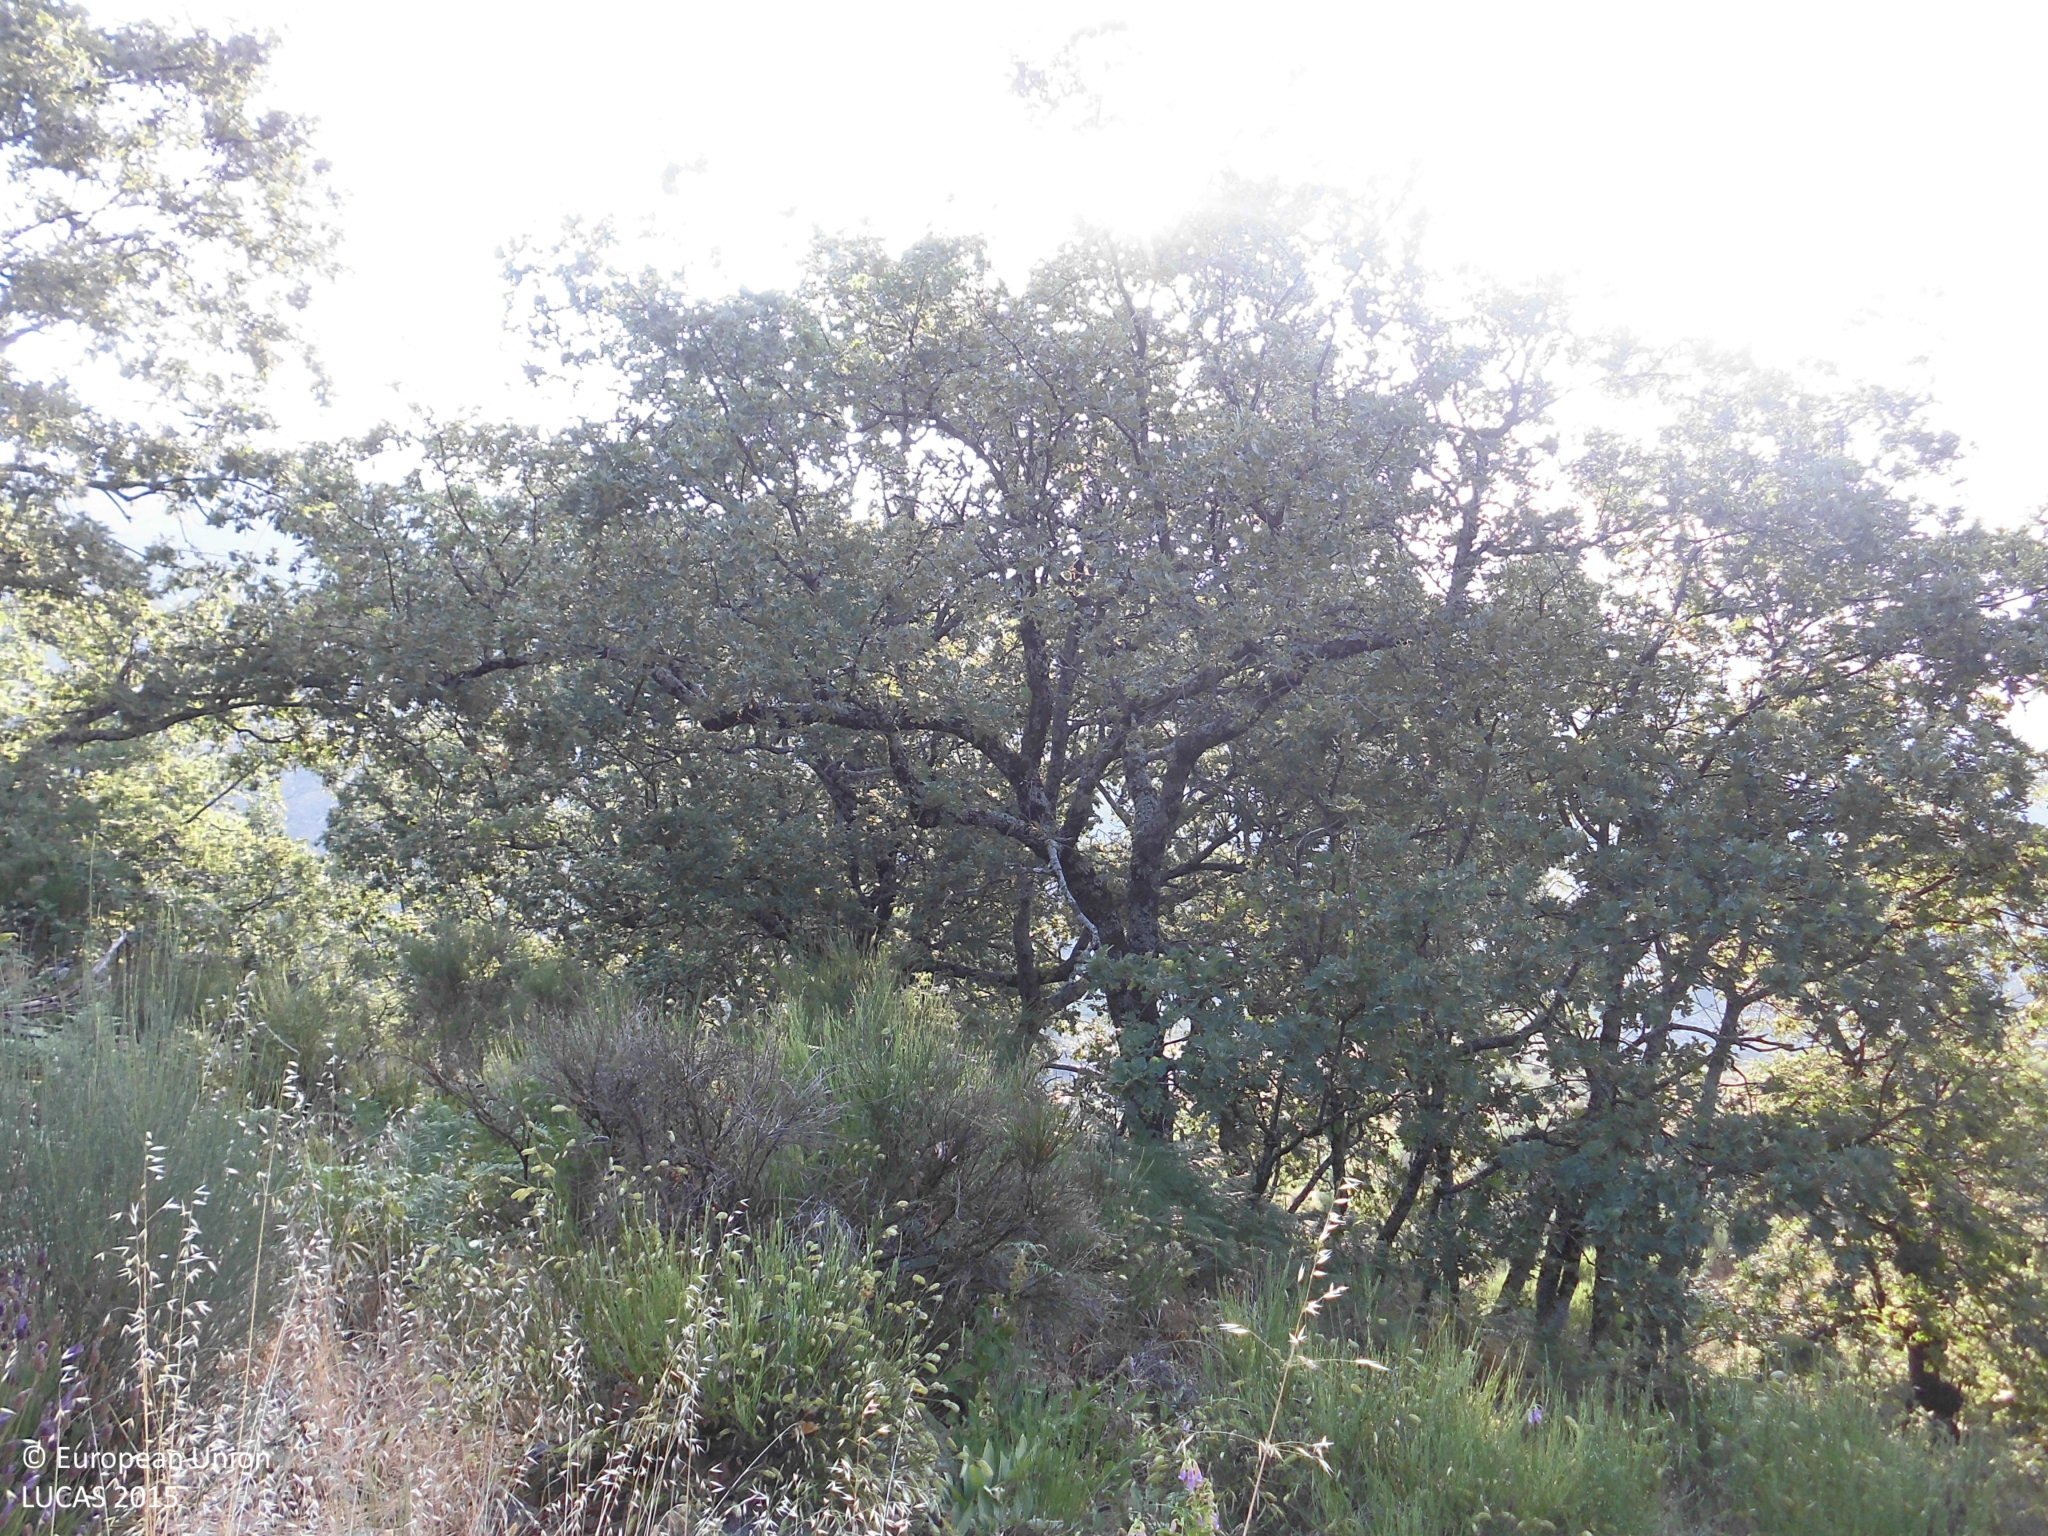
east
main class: Woodland
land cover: Broadleaved woodland
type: thermophilous deciduous forest
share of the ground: 25 - 50 %
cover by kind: broadleaved forest trees 45 %, shrubs 25 %, herbaceous plants 25 %, lichens and mosses 5 %
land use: Forestry
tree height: > 5 m
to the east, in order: Broadleaved woodland; Rivers and streams; Shrubland without tree cover; Fences; Shrubland without tree cover; Rock outcrops; Shrubland without tree cover
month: June
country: ES
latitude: 40.1506
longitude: -5.7143
